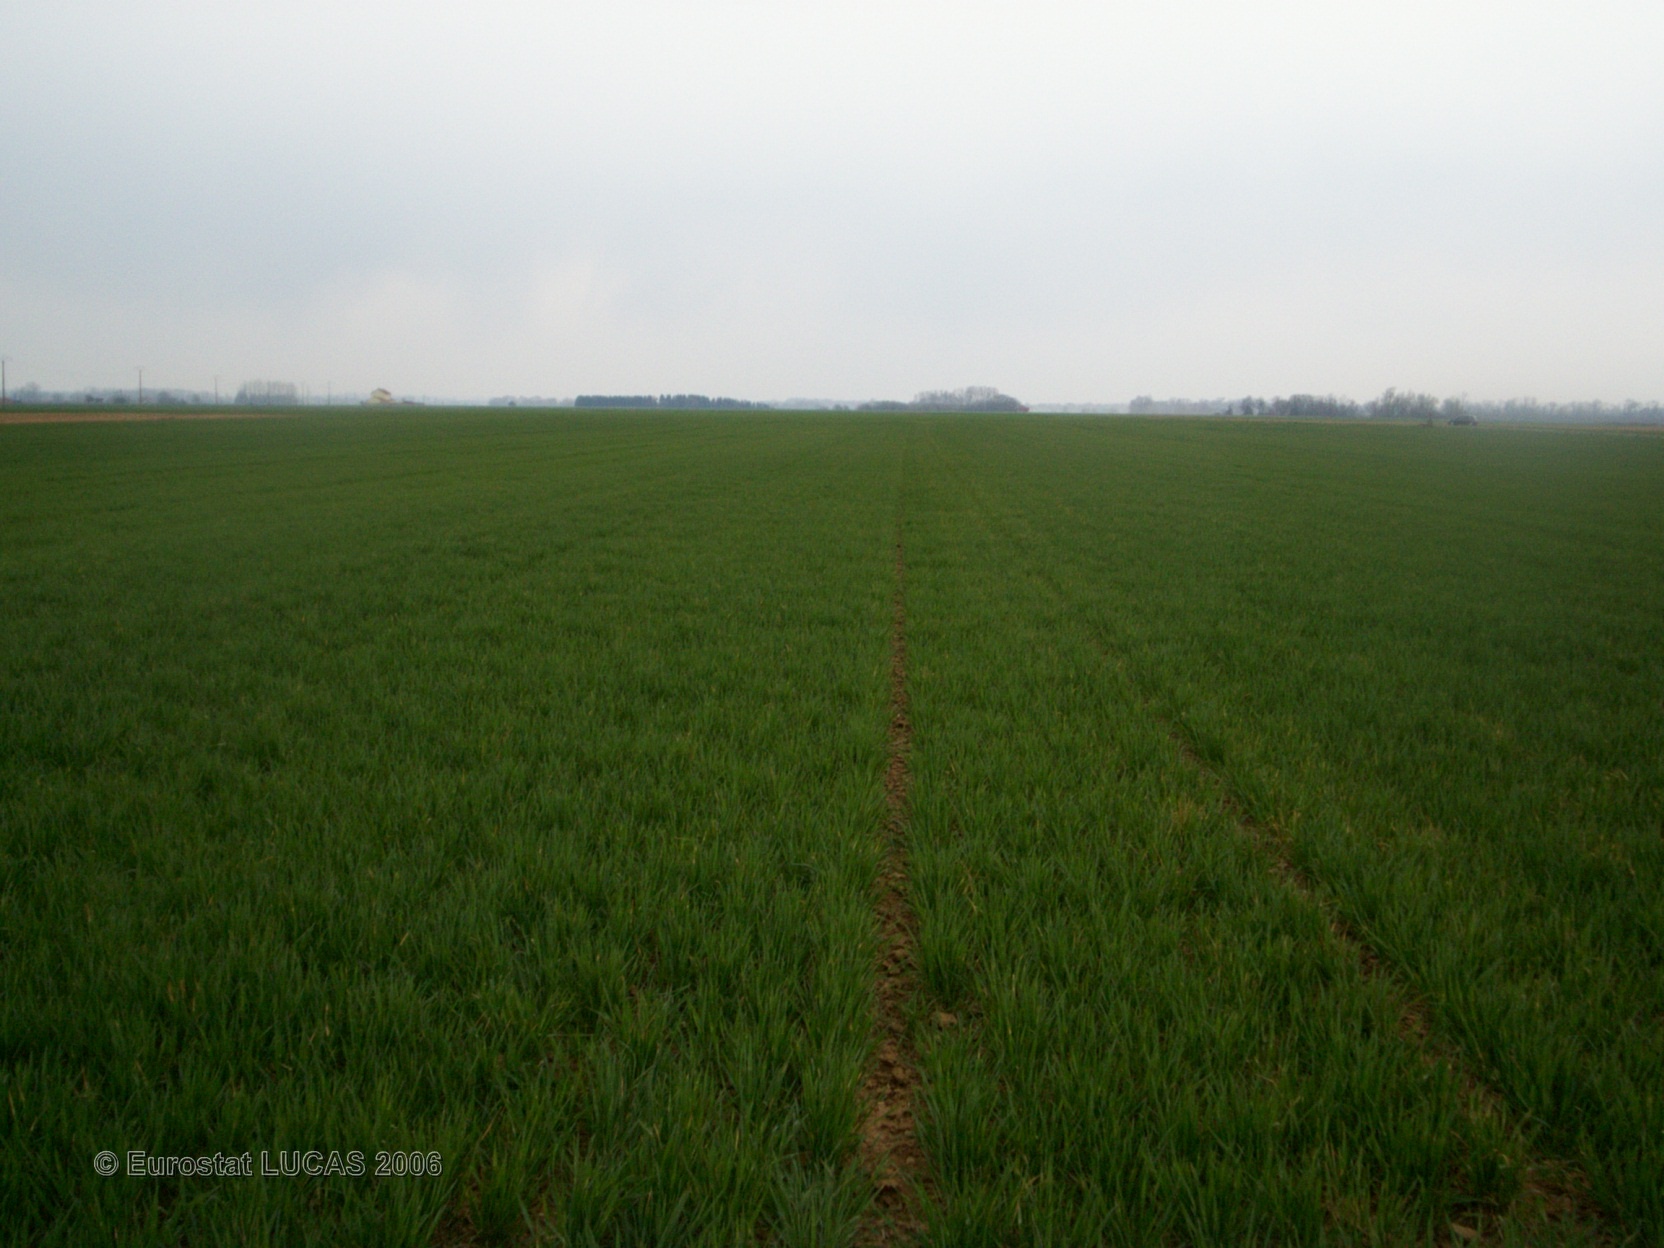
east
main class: Cropland
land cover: Common wheat
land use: Agriculture (excluding fallow land and kitchen gardens)
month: April
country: FR
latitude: 48.6802
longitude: 4.8503
